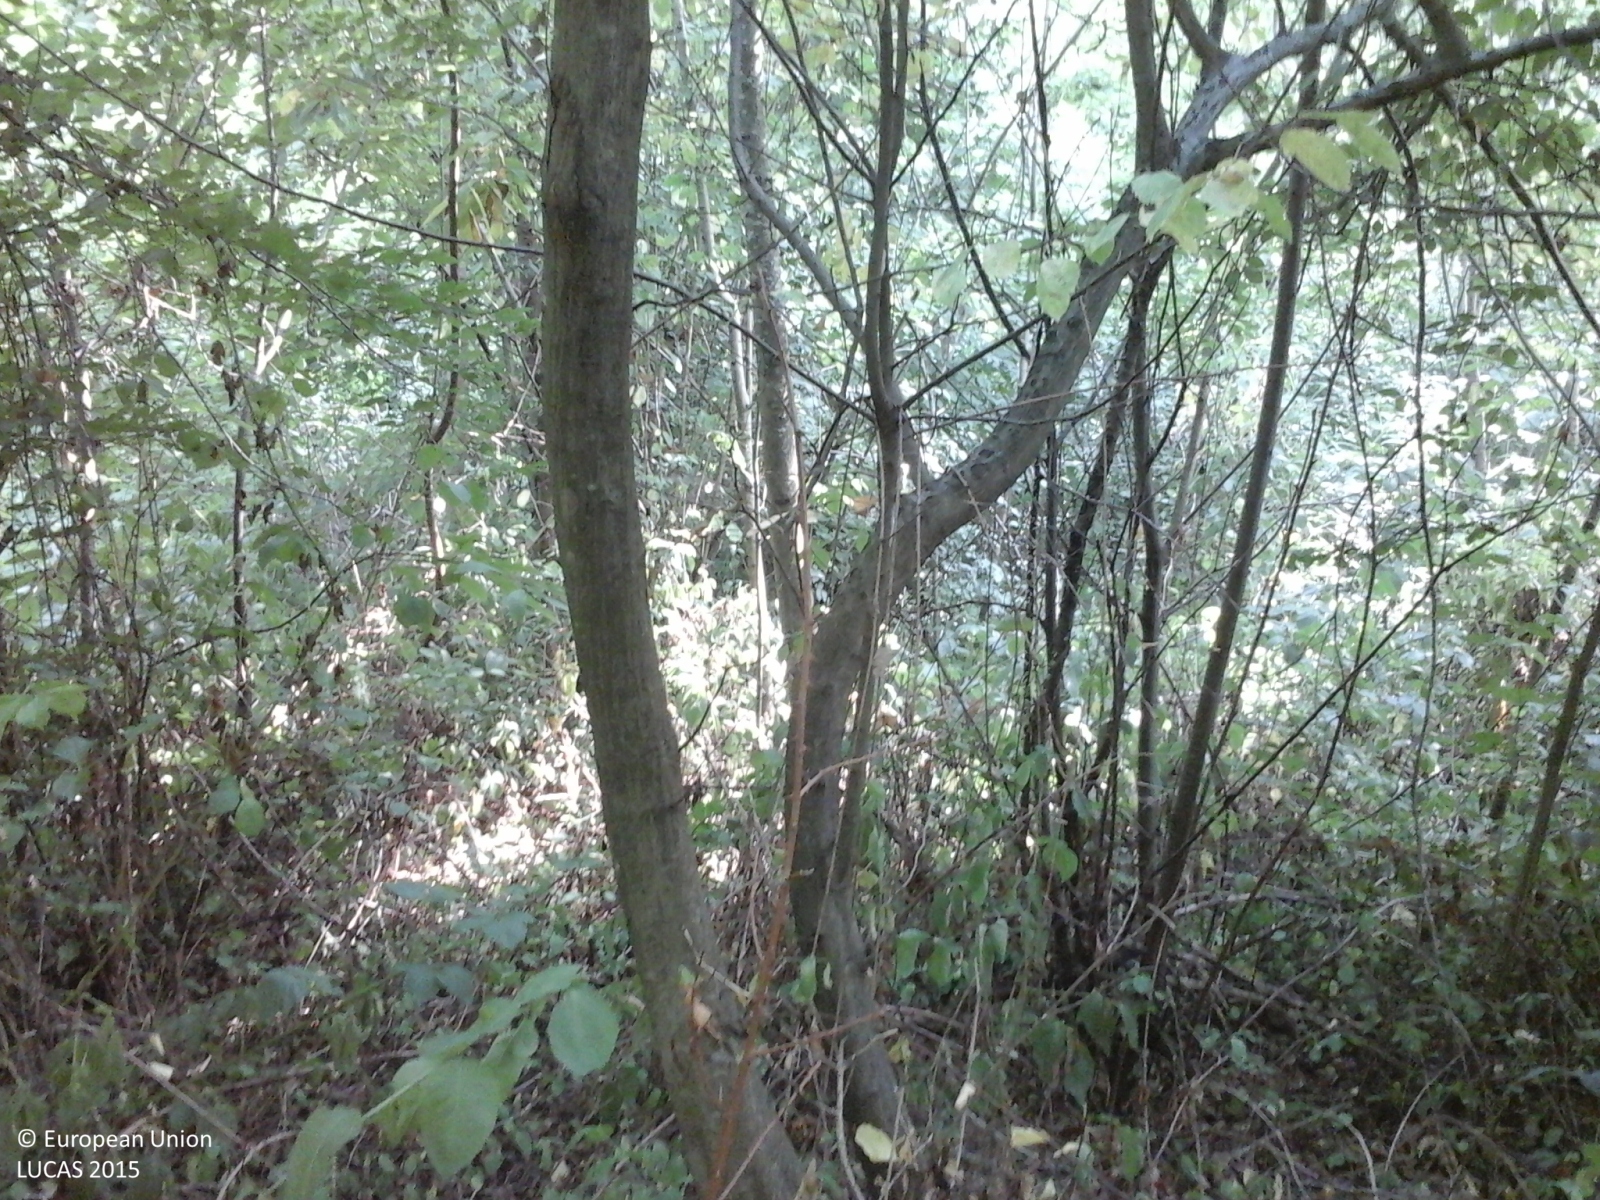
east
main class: Woodland
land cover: Broadleaved woodland
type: thermophilous deciduous forest
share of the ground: > 75 %
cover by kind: broadleaved forest trees 100 %
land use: Forestry
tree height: > 5 m
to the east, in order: Broadleaved woodland
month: July
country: IT
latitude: 45.3907
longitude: 7.7683
